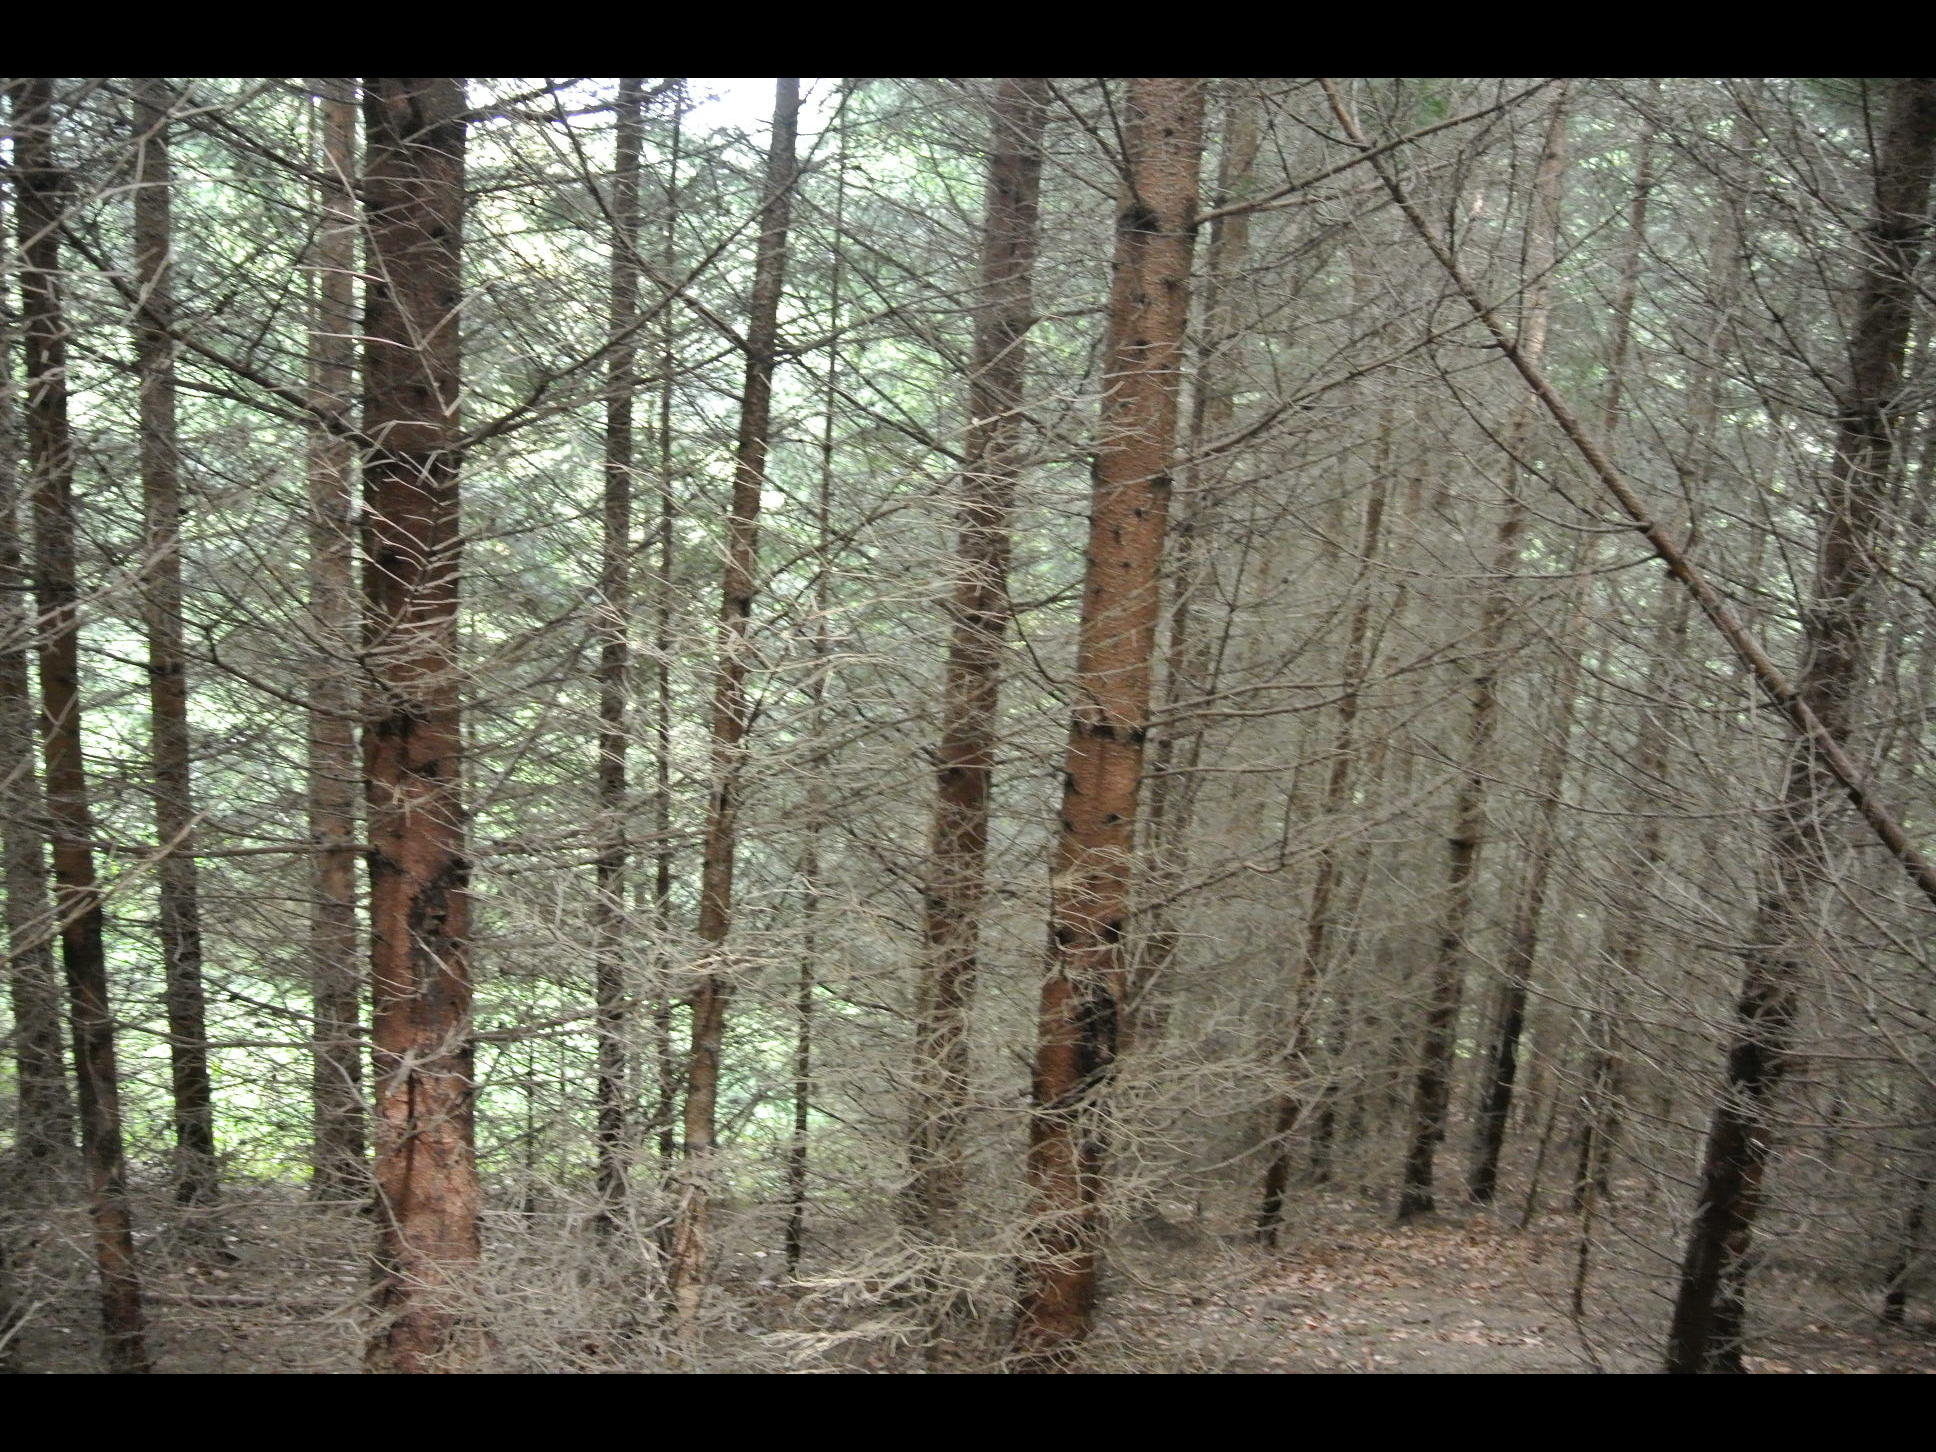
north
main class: Woodland
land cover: Spruce dominated coniferous woodland
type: alpine coniferous forest
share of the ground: > 75 %
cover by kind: coniferous forest trees 100 %
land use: Forestry
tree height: > 5 m
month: May
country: AT
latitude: 47.8614
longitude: 16.0048
